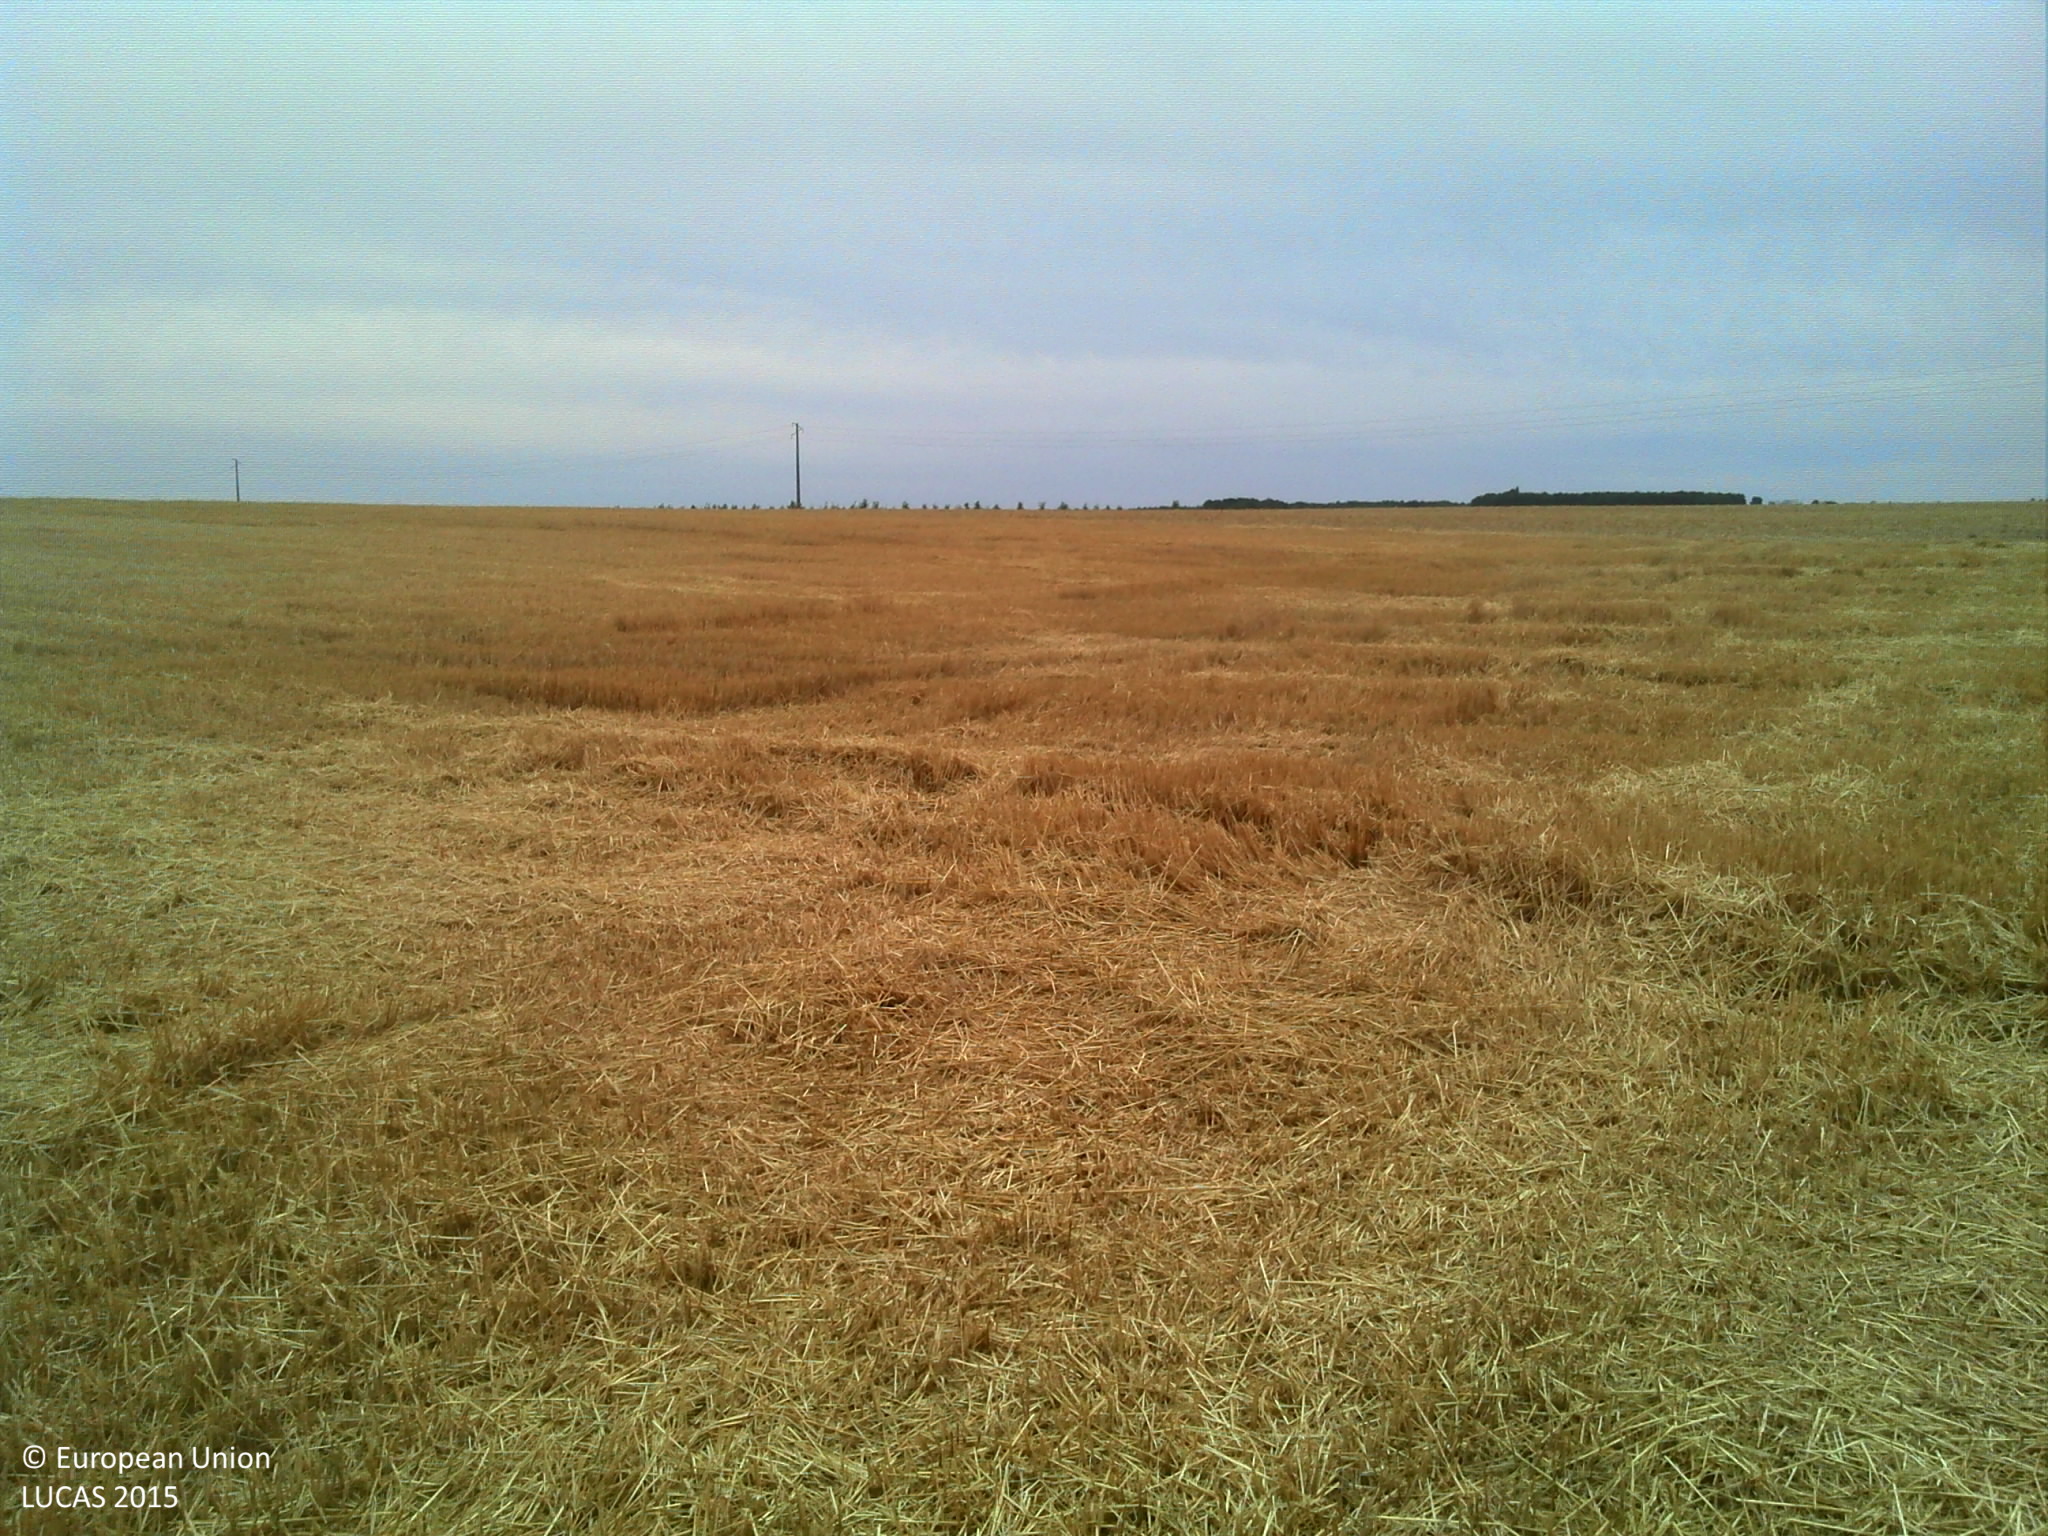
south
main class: Cropland
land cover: Common wheat
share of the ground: > 75 %
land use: Agriculture (excluding fallow land and kitchen gardens)
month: July
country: FR
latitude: 47.1125
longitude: 0.3716
